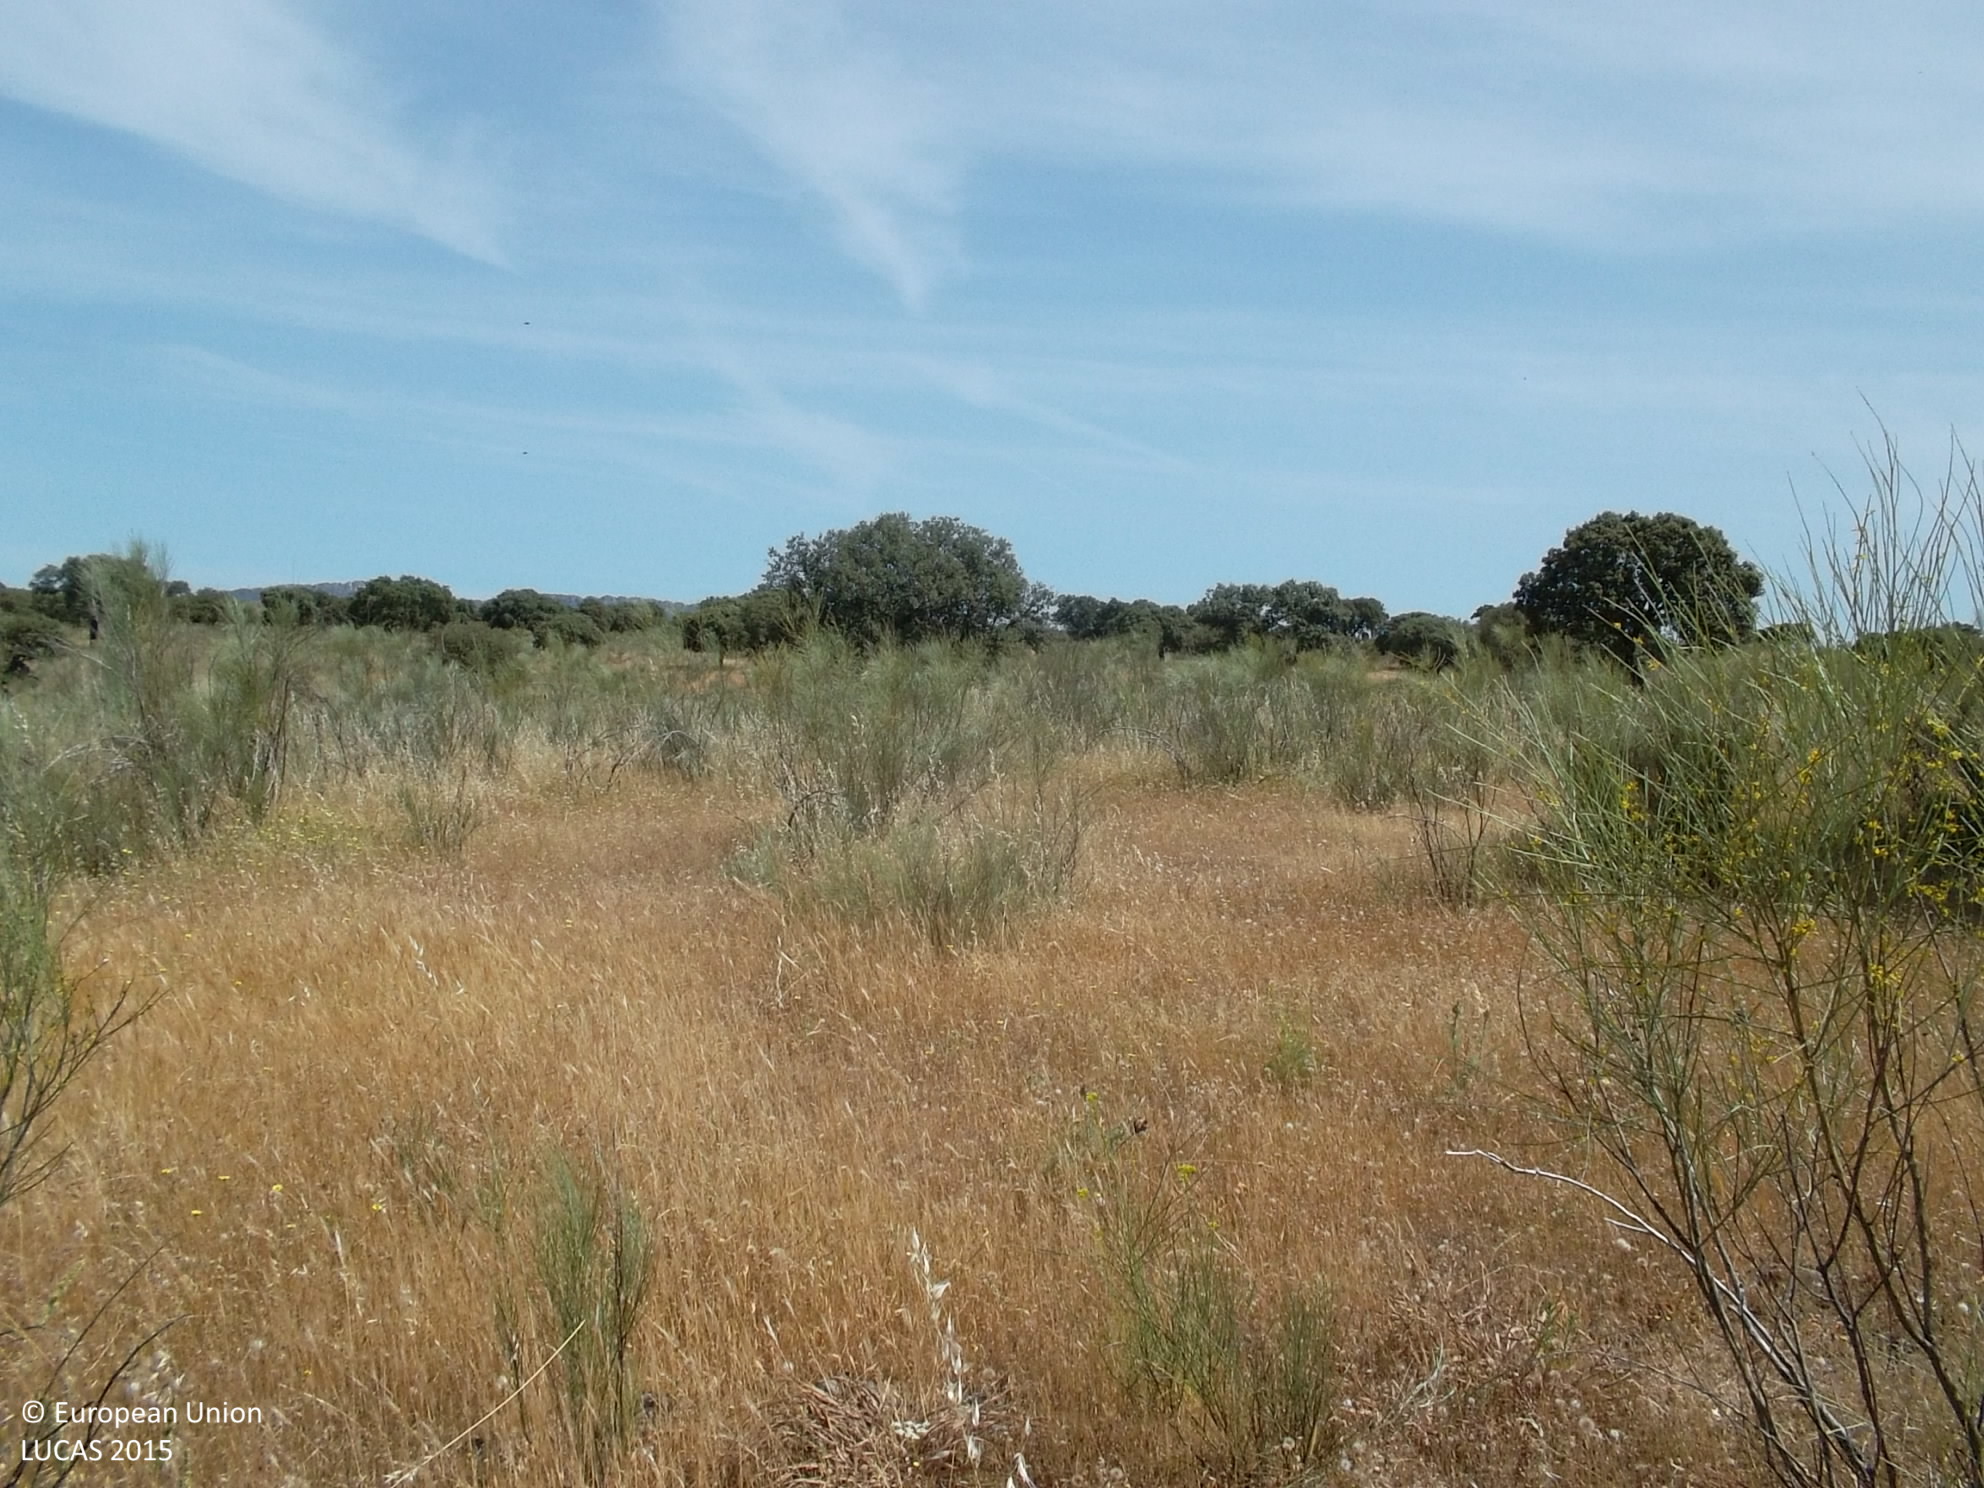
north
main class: Woodland
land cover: Broadleaved woodland
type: broadleaved evergreen forest
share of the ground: 10 - 25 %
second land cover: Shrubland without tree cover
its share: 50 - 75 %
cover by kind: herbaceous plants 55 %, shrubs 30 %, broadleaved forest trees 15 %
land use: Forestry
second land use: Agriculture (excluding fallow land and kitchen gardens)
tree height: > 5 m
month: May
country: ES
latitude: 38.6539
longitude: -4.7229
